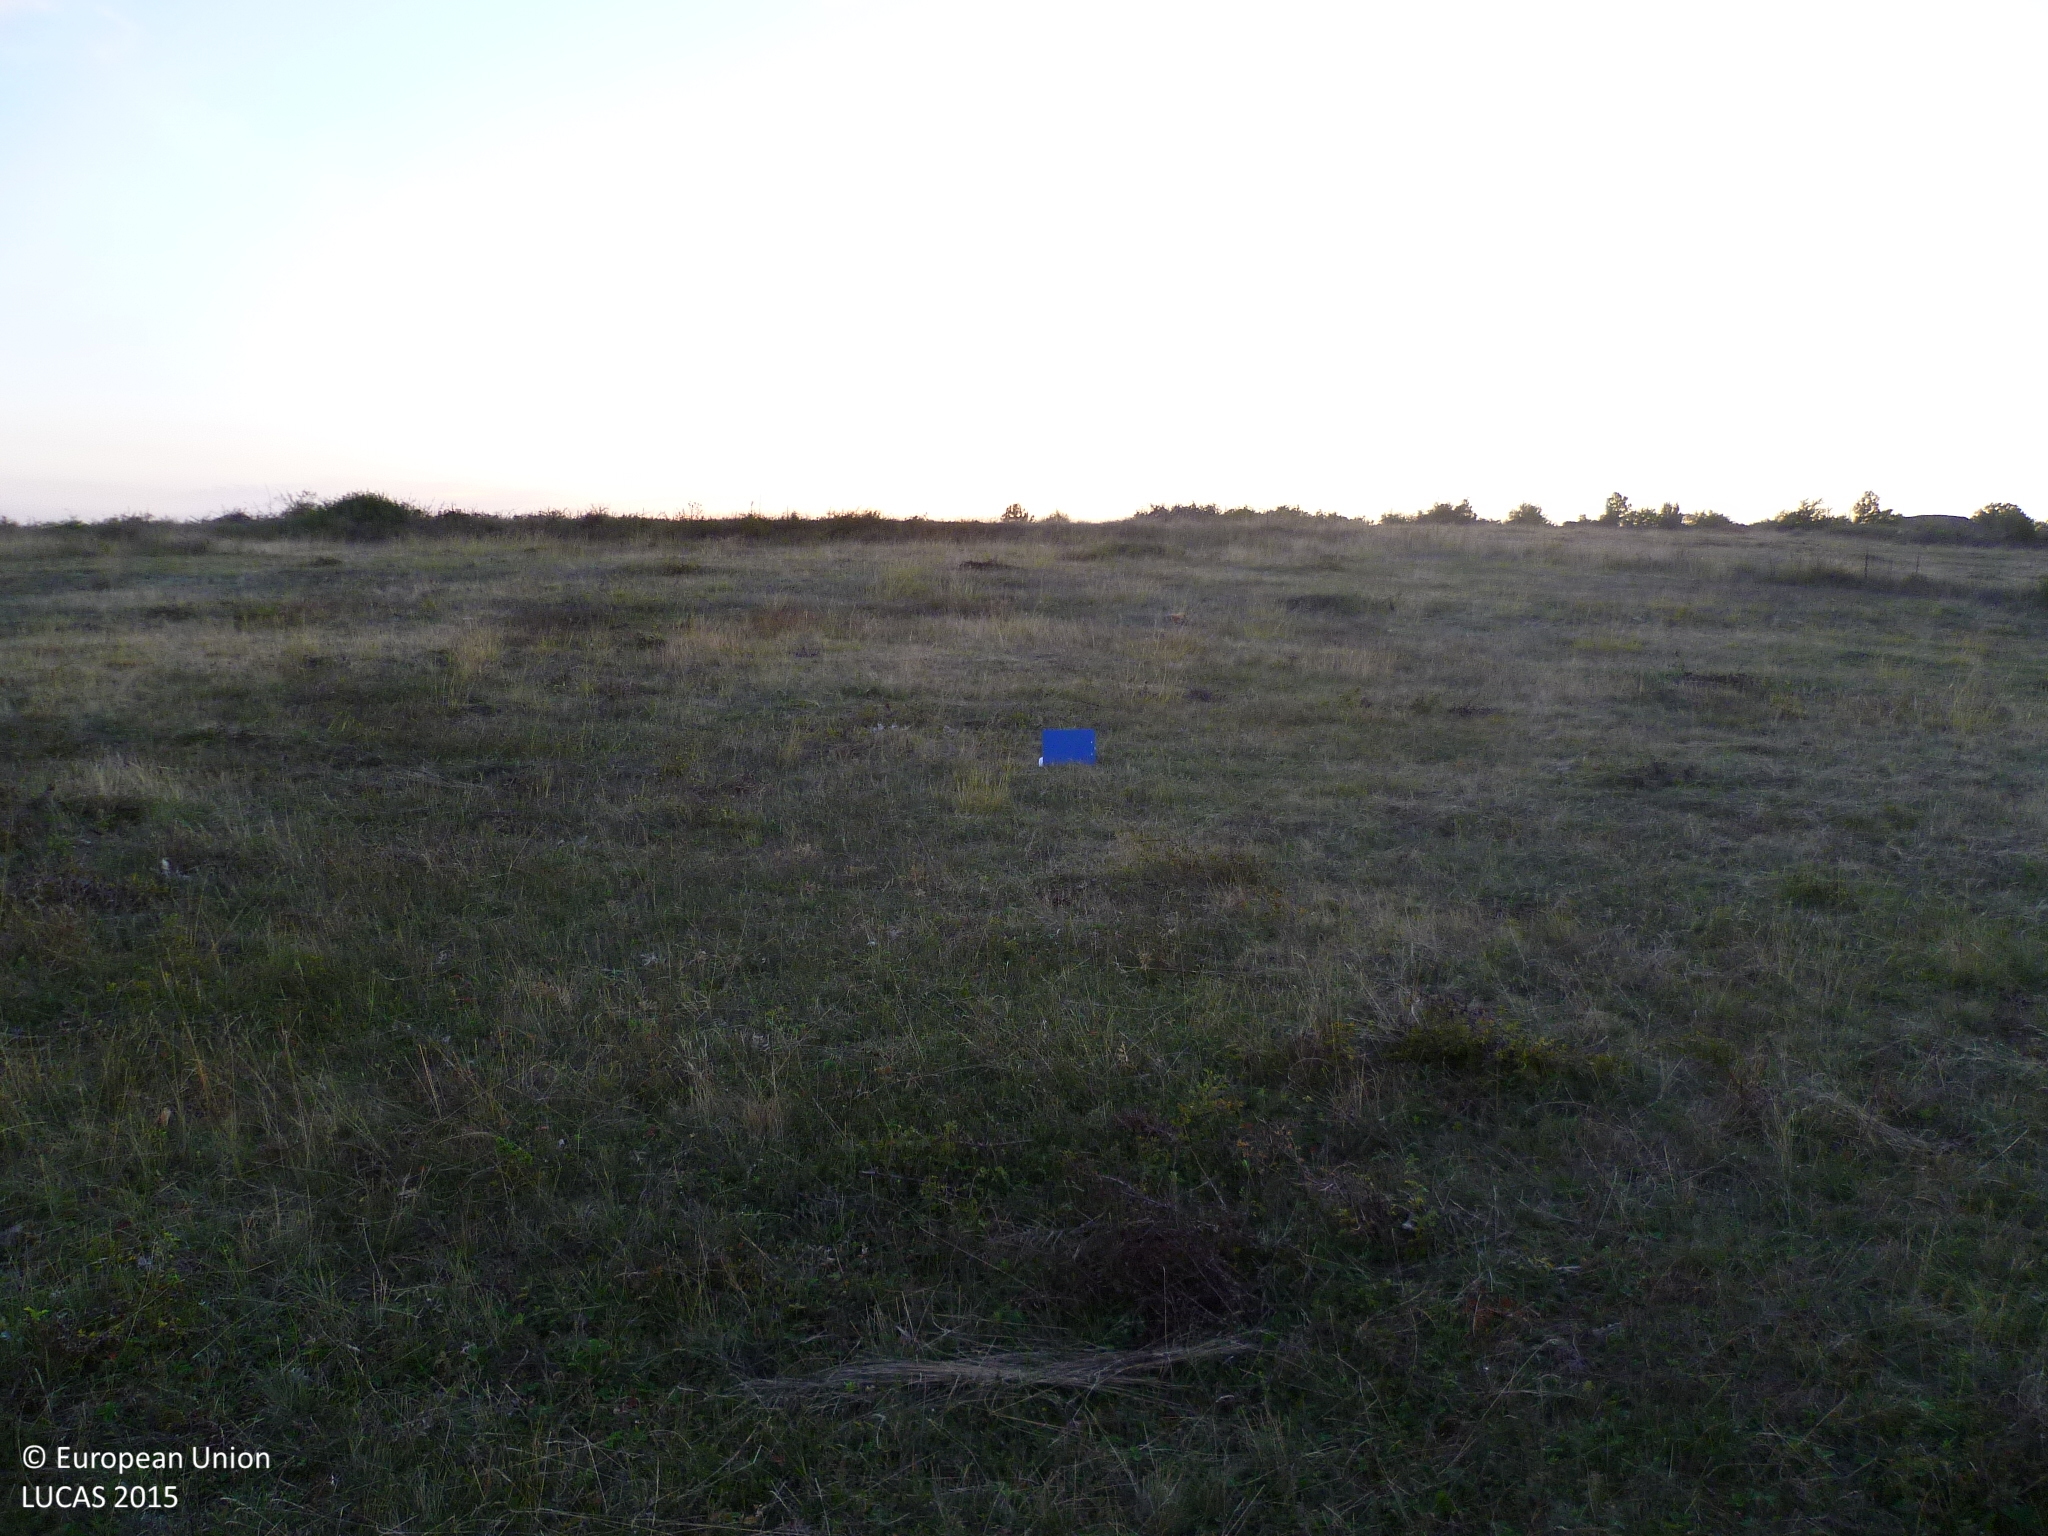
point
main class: Grassland
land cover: Grassland without tree/shrub cover
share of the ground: > 75 %
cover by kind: herbaceous plants 100 %
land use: Agriculture (excluding fallow land and kitchen gardens)
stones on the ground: > 50 %
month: October
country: BG
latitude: 43.0267
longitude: 22.9298
